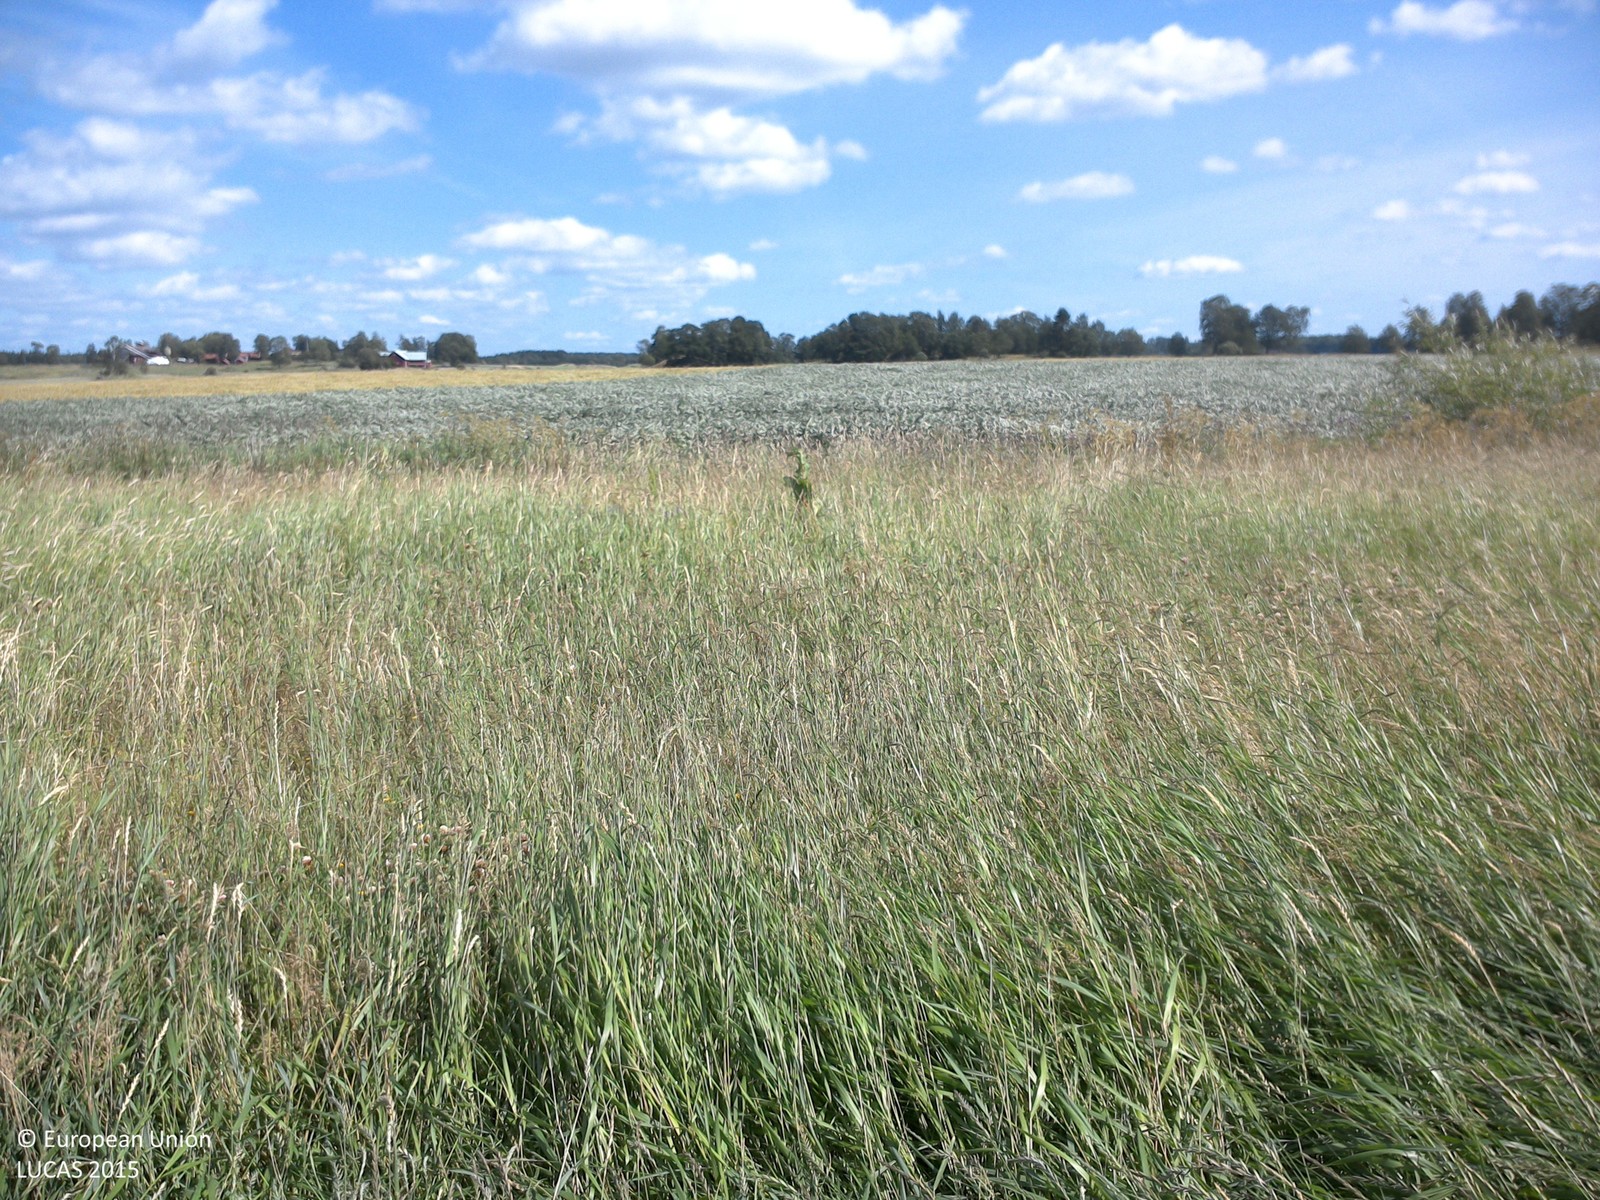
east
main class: Cropland
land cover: Barley
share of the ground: > 75 %
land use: Agriculture (excluding fallow land and kitchen gardens)
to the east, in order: Barley; Grassland without tree/shrub cover; Rivers and streams; Dry pulses; Arable land (only in case pi)
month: July
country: SE
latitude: 58.3285
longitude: 15.3734
